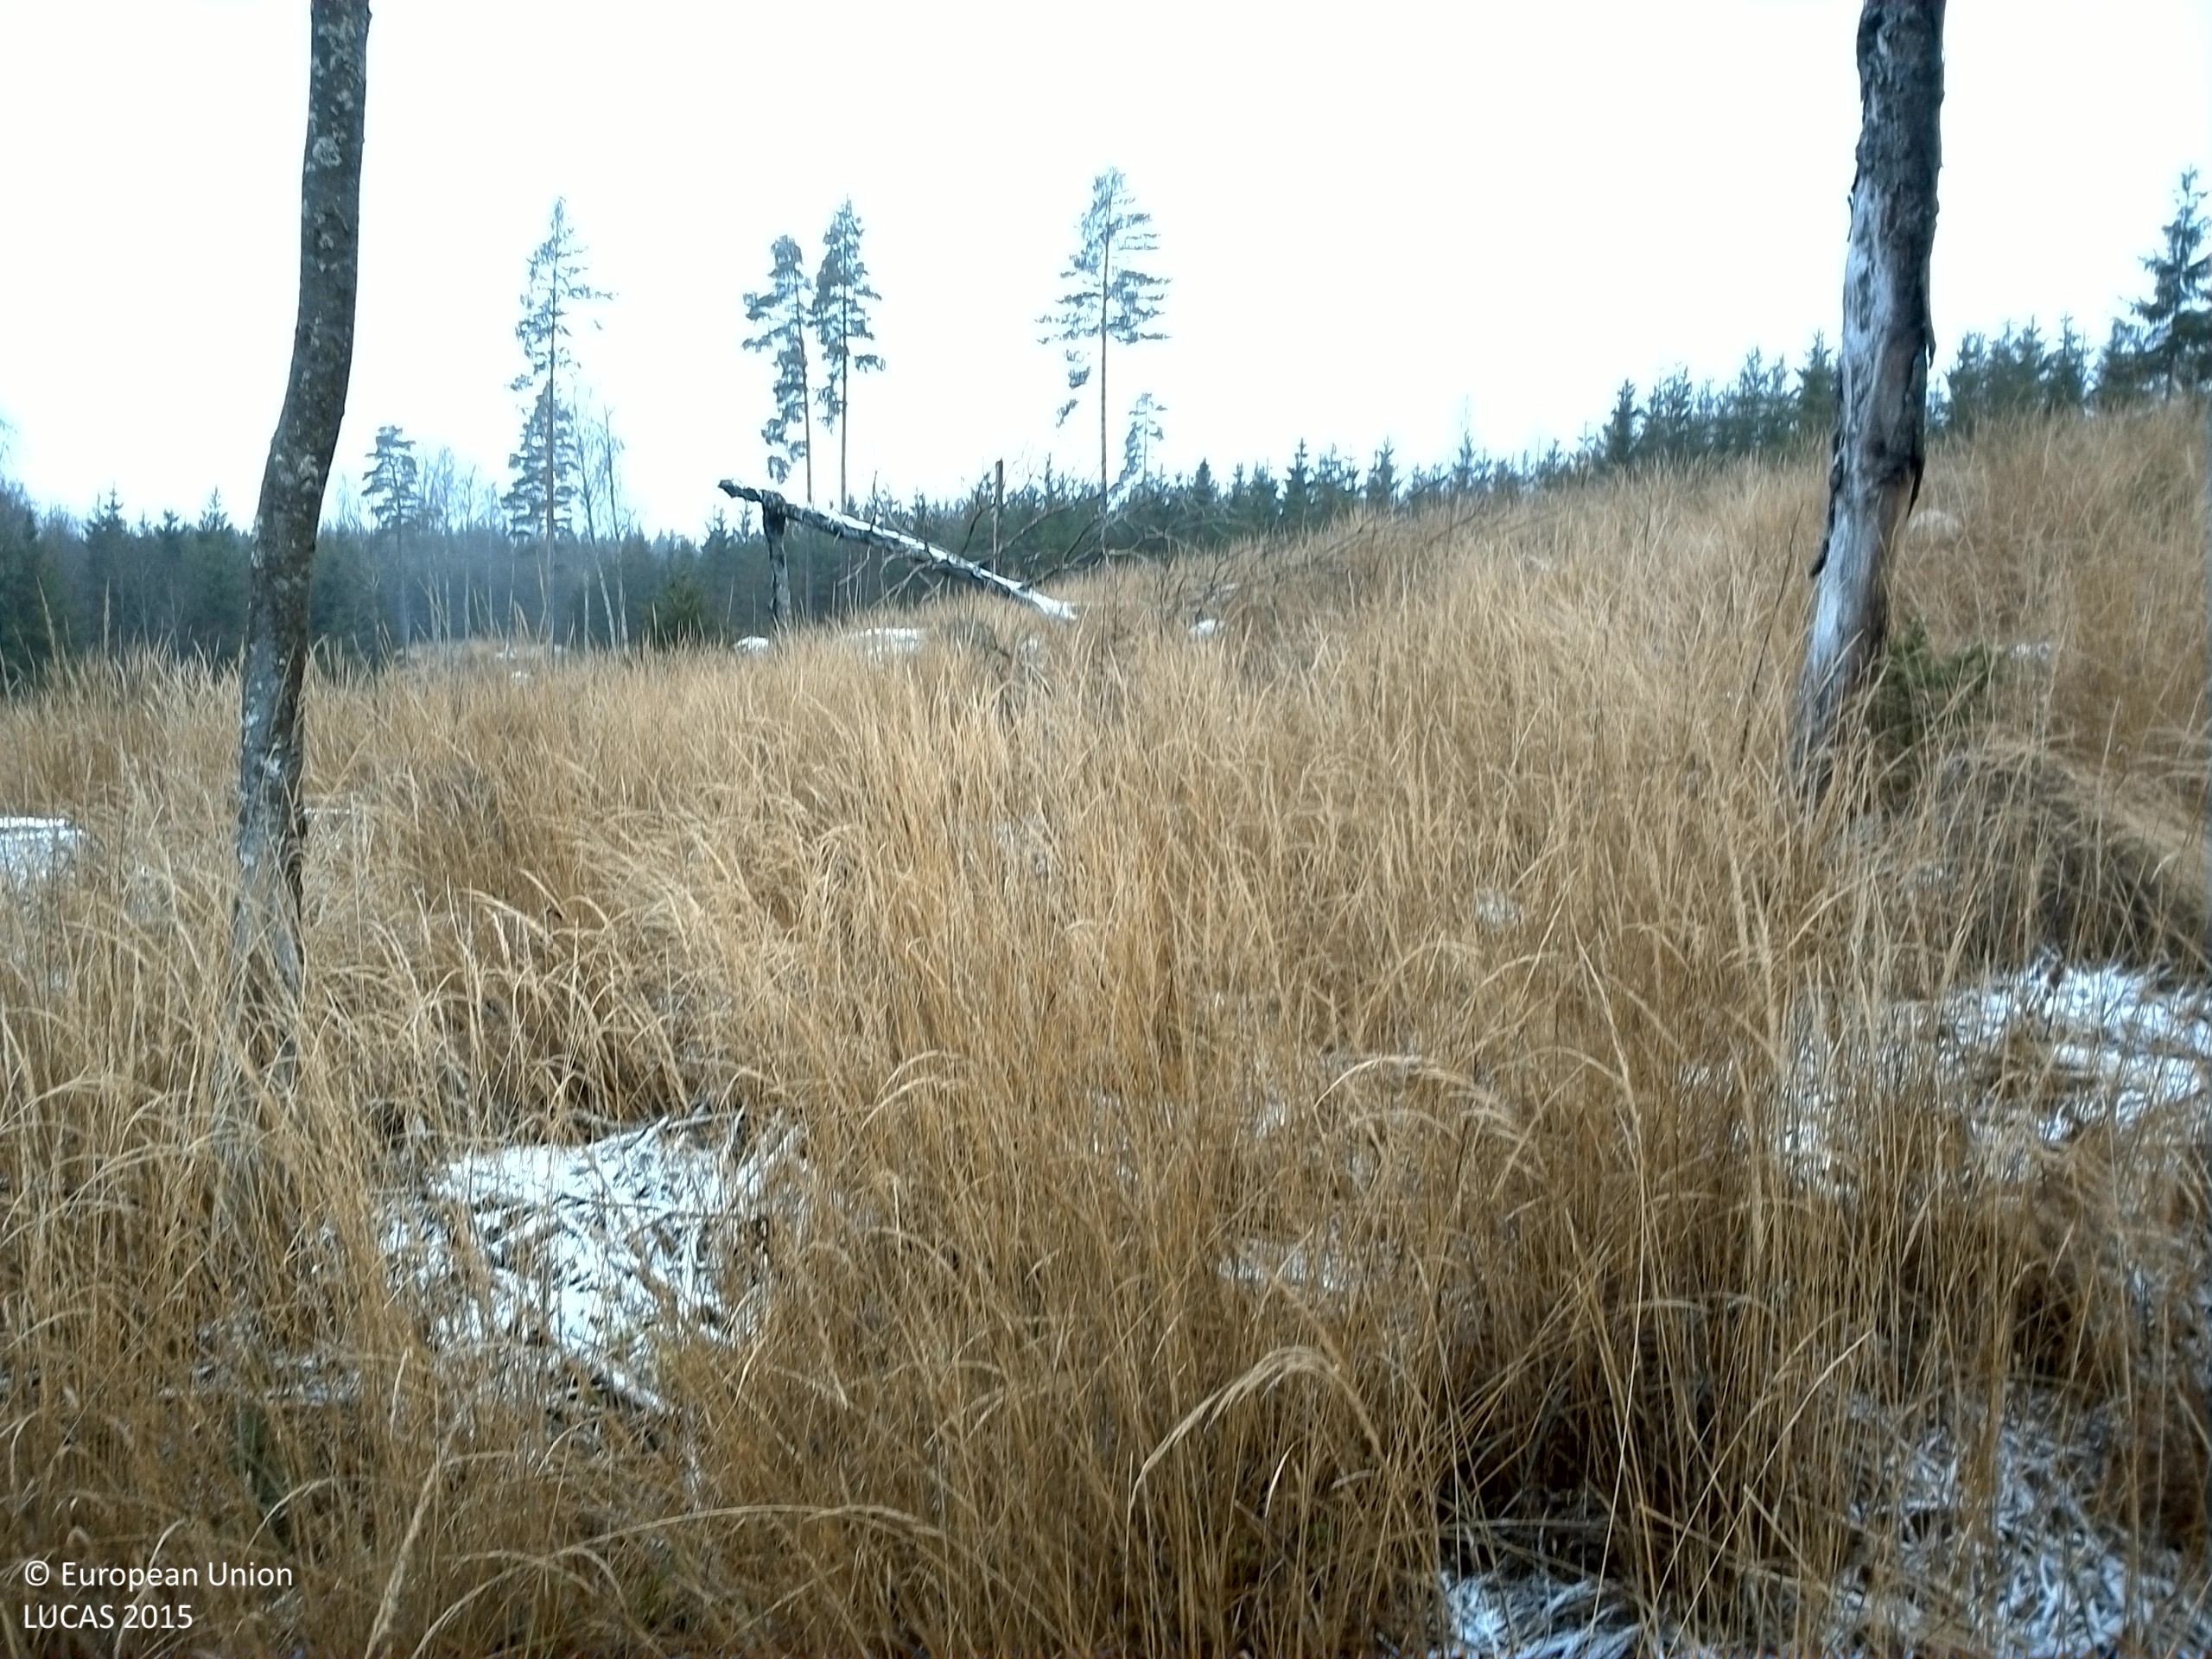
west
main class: Grassland
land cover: Grassland with sparse tree/shrub cover
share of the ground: > 75 %
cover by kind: herbaceous plants 90 %, broadleaved forest trees 5 %, consolidated bare surface 5 %
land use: Forestry
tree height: > 5 m
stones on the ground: < 10 %
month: November
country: SE
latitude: 60.2455
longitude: 16.5469
